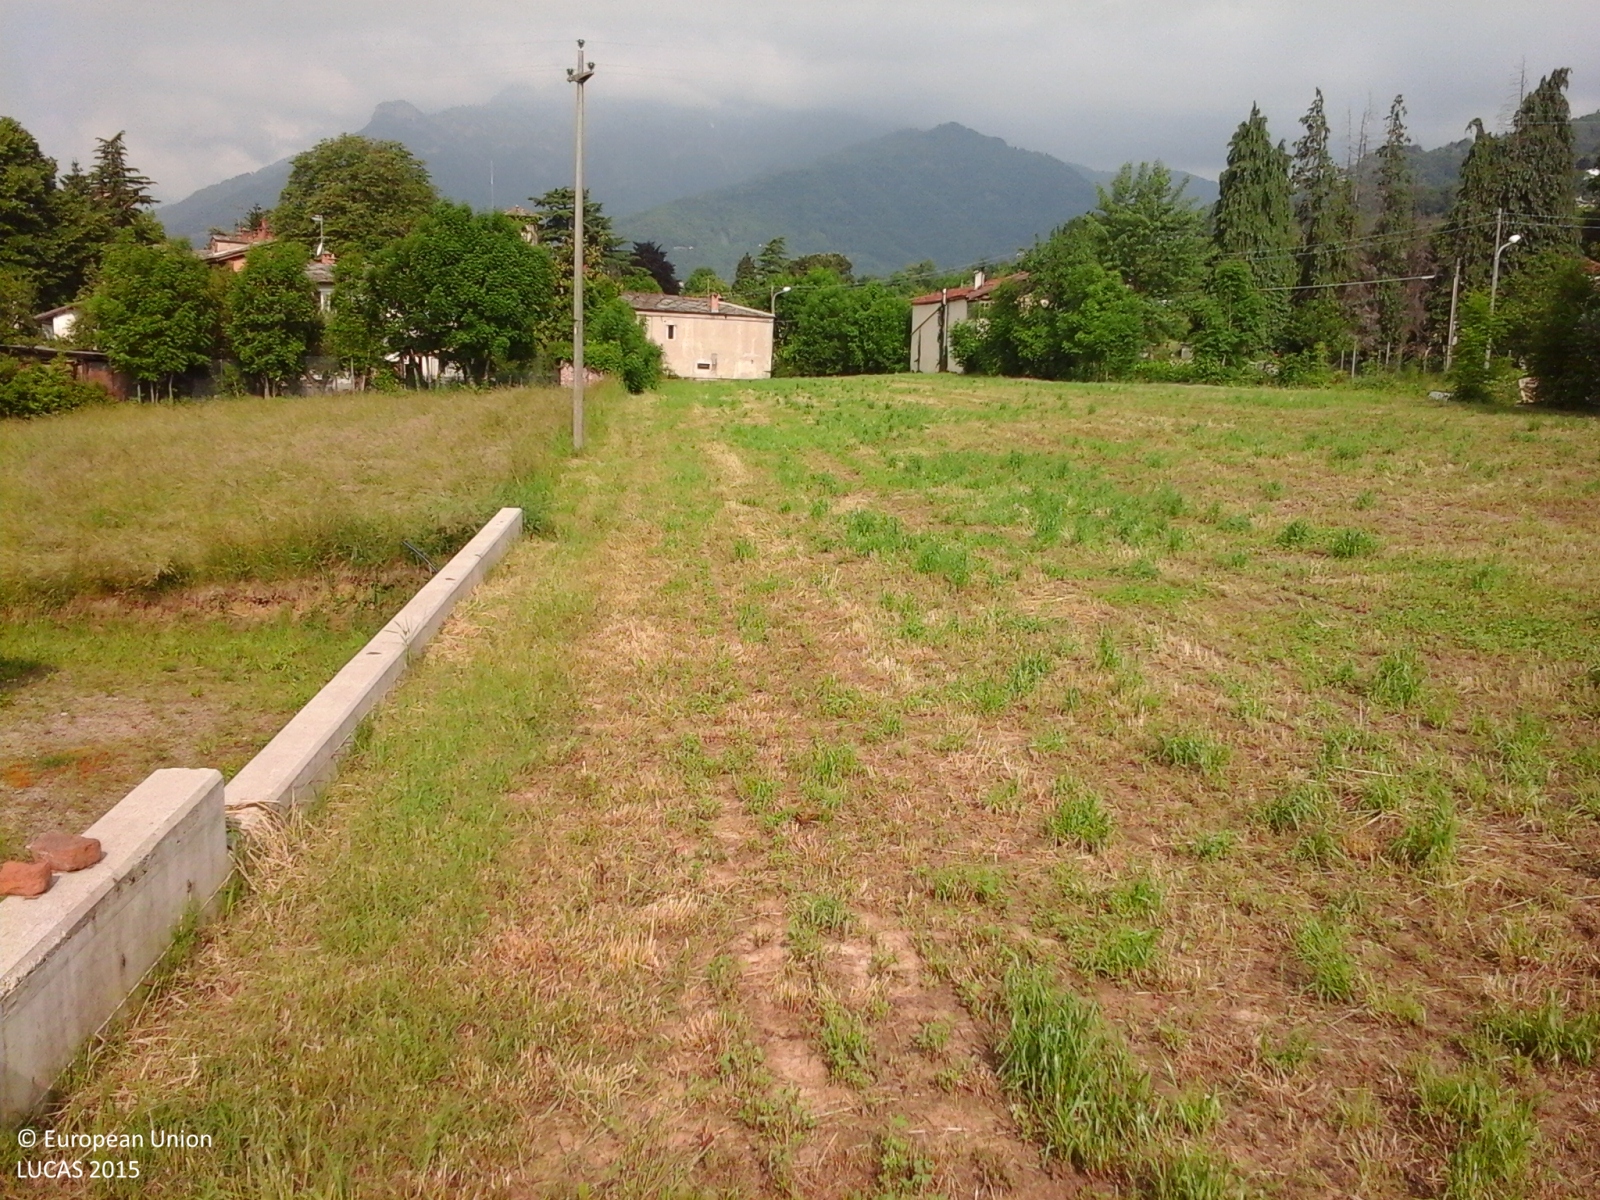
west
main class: Cropland
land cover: Temporary grasslands
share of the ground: > 75 %
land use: Agriculture (excluding fallow land and kitchen gardens)
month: May
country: IT
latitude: 44.8196
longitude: 7.2607
